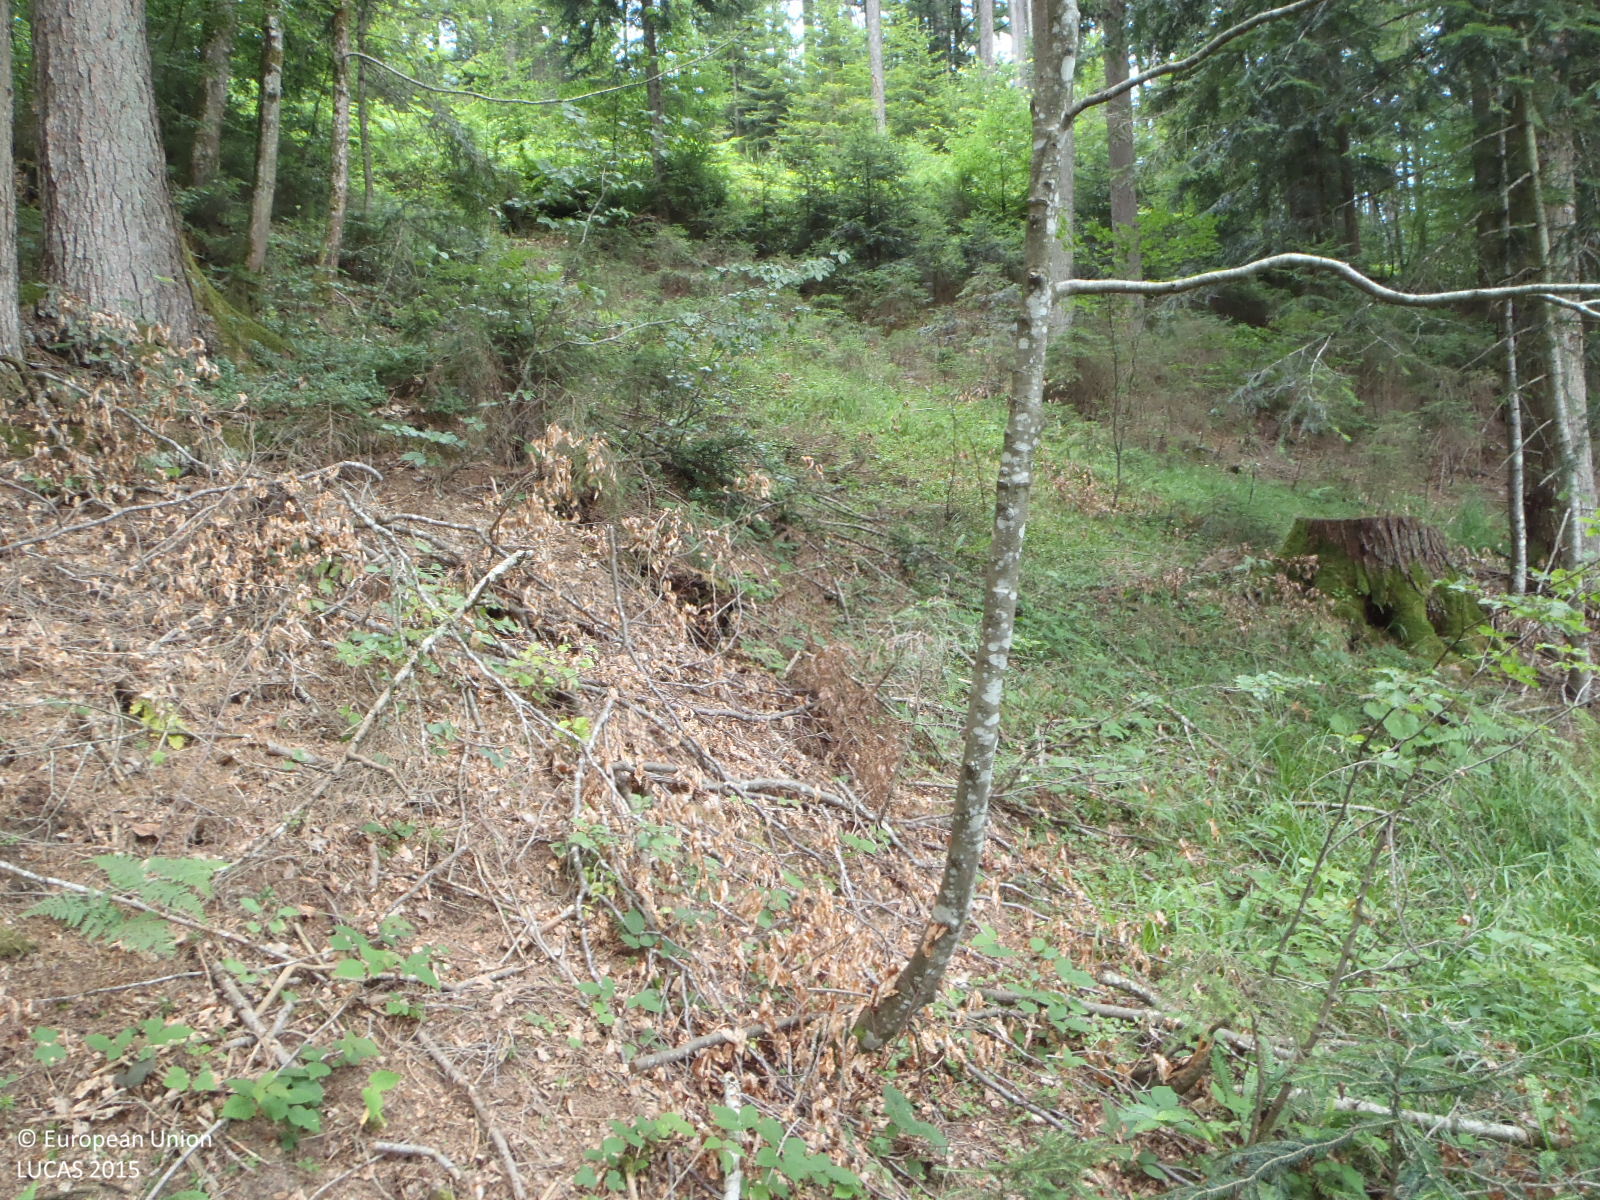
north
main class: Woodland
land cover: Other mixed woodland
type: alpine coniferous forest
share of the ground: > 75 %
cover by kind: coniferous forest trees 50 %, broadleaved forest trees 30 %, herbaceous plants 10 %, shrubs 5 %, lichens and mosses 5 %
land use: Forestry
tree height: > 5 m
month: July
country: AT
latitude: 47.5318
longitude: 12.3761
